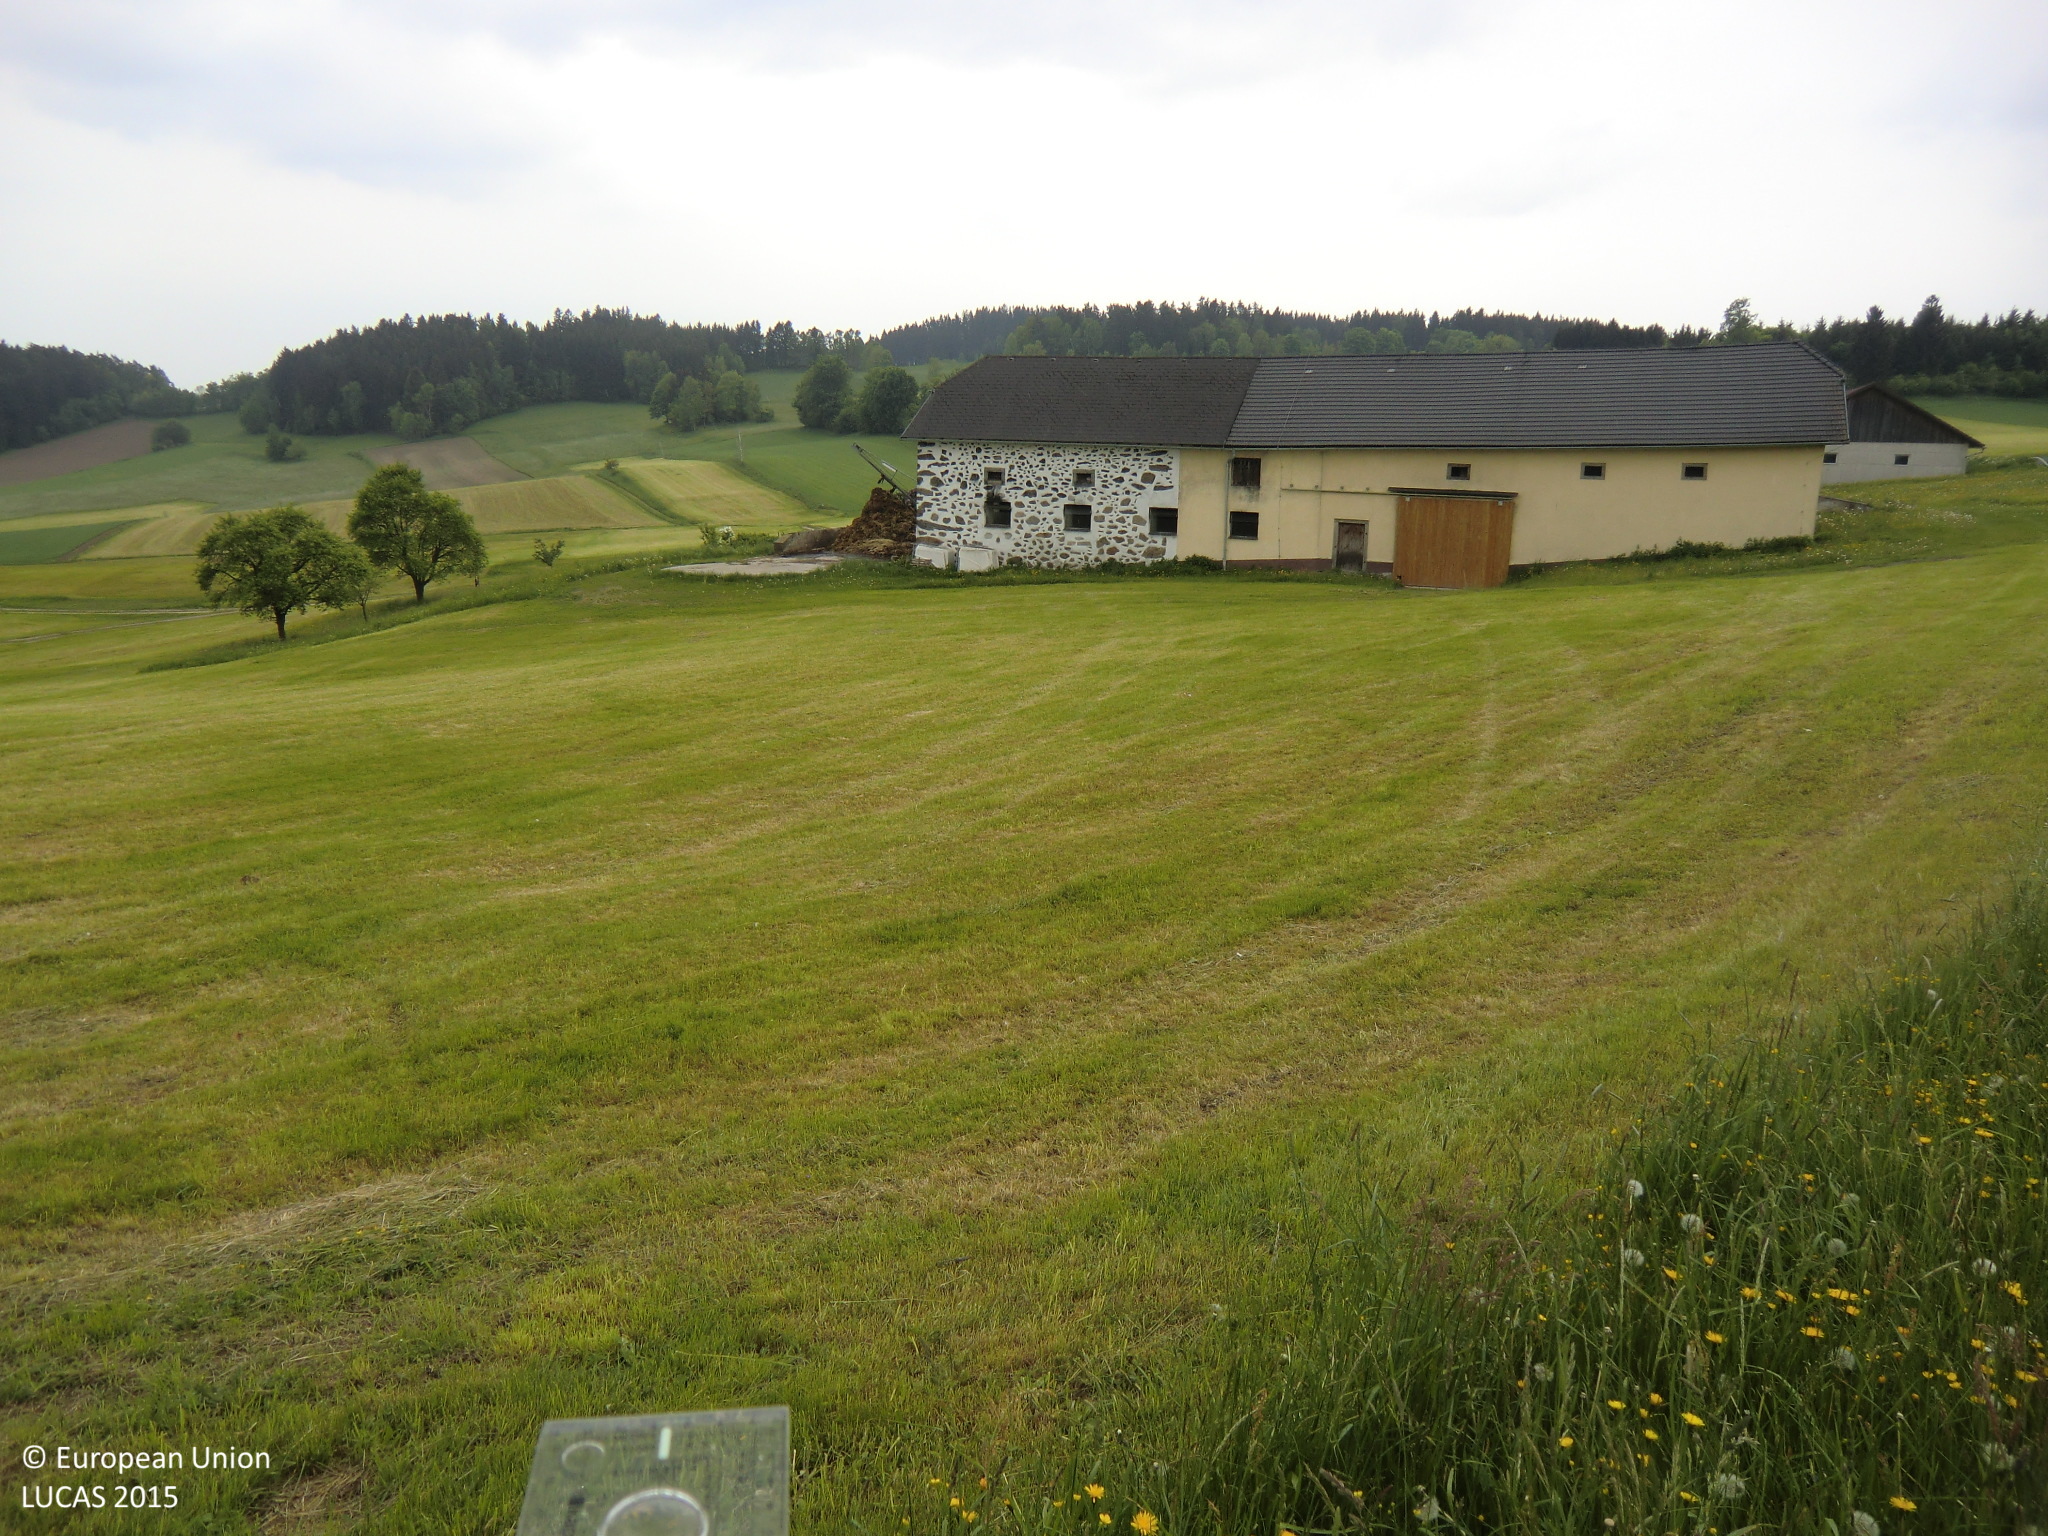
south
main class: Grassland
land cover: Grassland without tree/shrub cover
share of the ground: > 75 %
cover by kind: herbaceous plants 100 %
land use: Agriculture (excluding fallow land and kitchen gardens)
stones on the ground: < 10 %
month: May
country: AT
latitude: 48.4951
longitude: 14.4257
